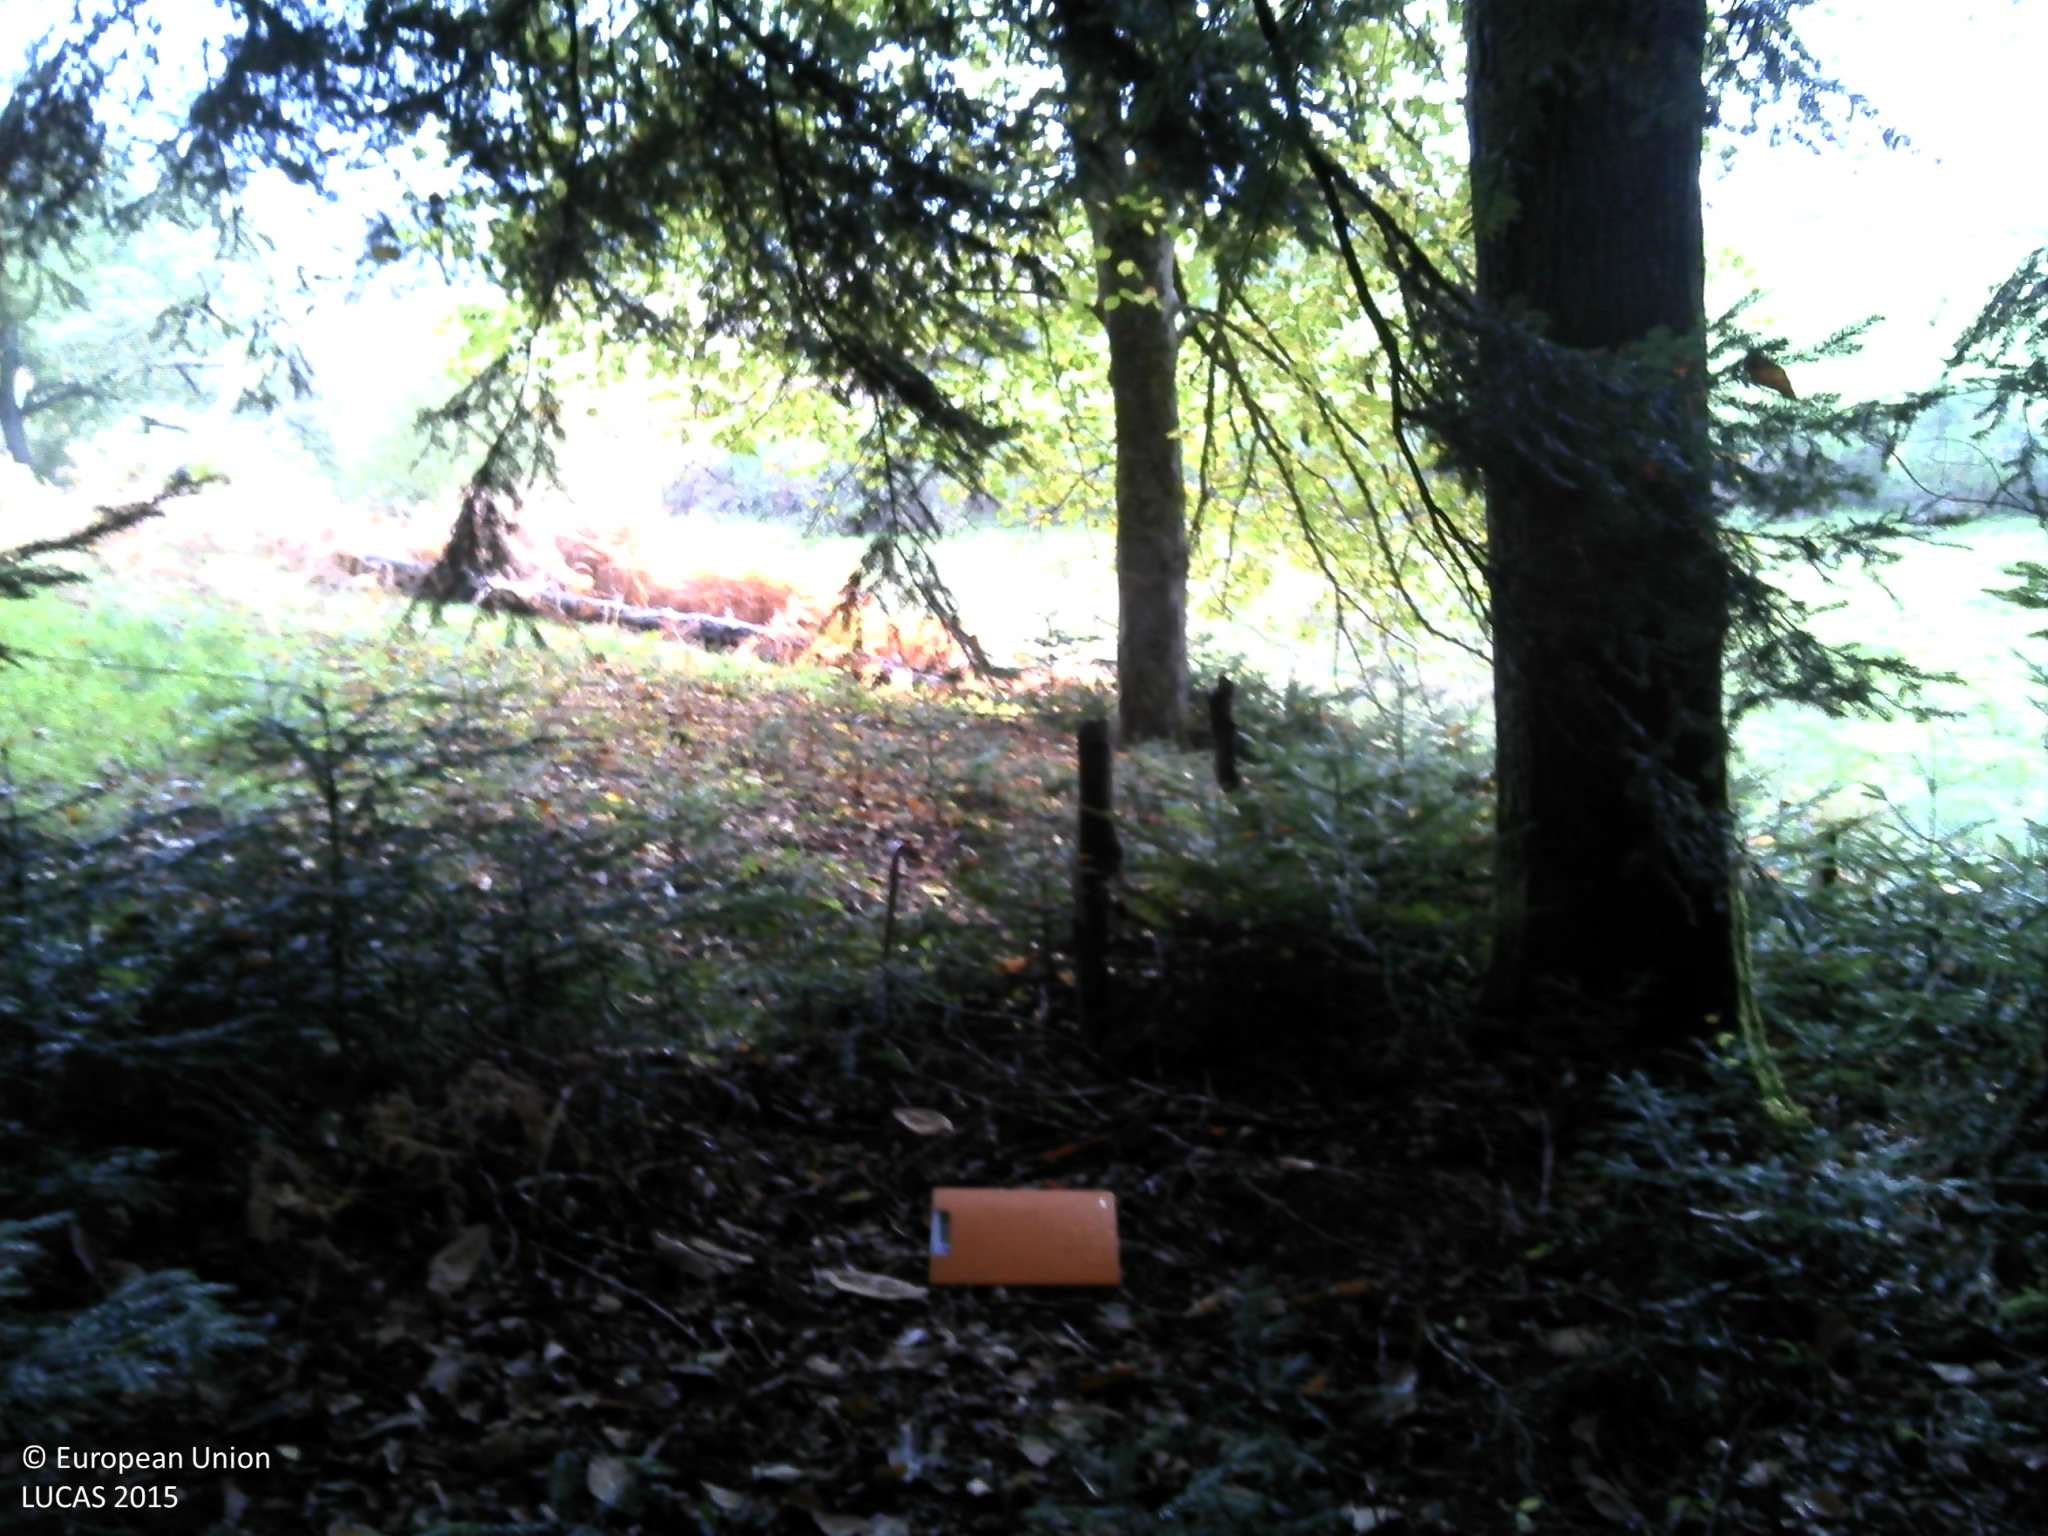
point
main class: Woodland
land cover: Spruce dominated mixed woodland
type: acidophilous oak and oak-birch forest
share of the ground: > 75 %
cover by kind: coniferous forest trees 60 %, broadleaved forest trees 30 %, unconsolidated bare surface 10 %
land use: Forestry
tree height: > 5 m
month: October
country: FR
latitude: 45.6596
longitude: 3.7004
